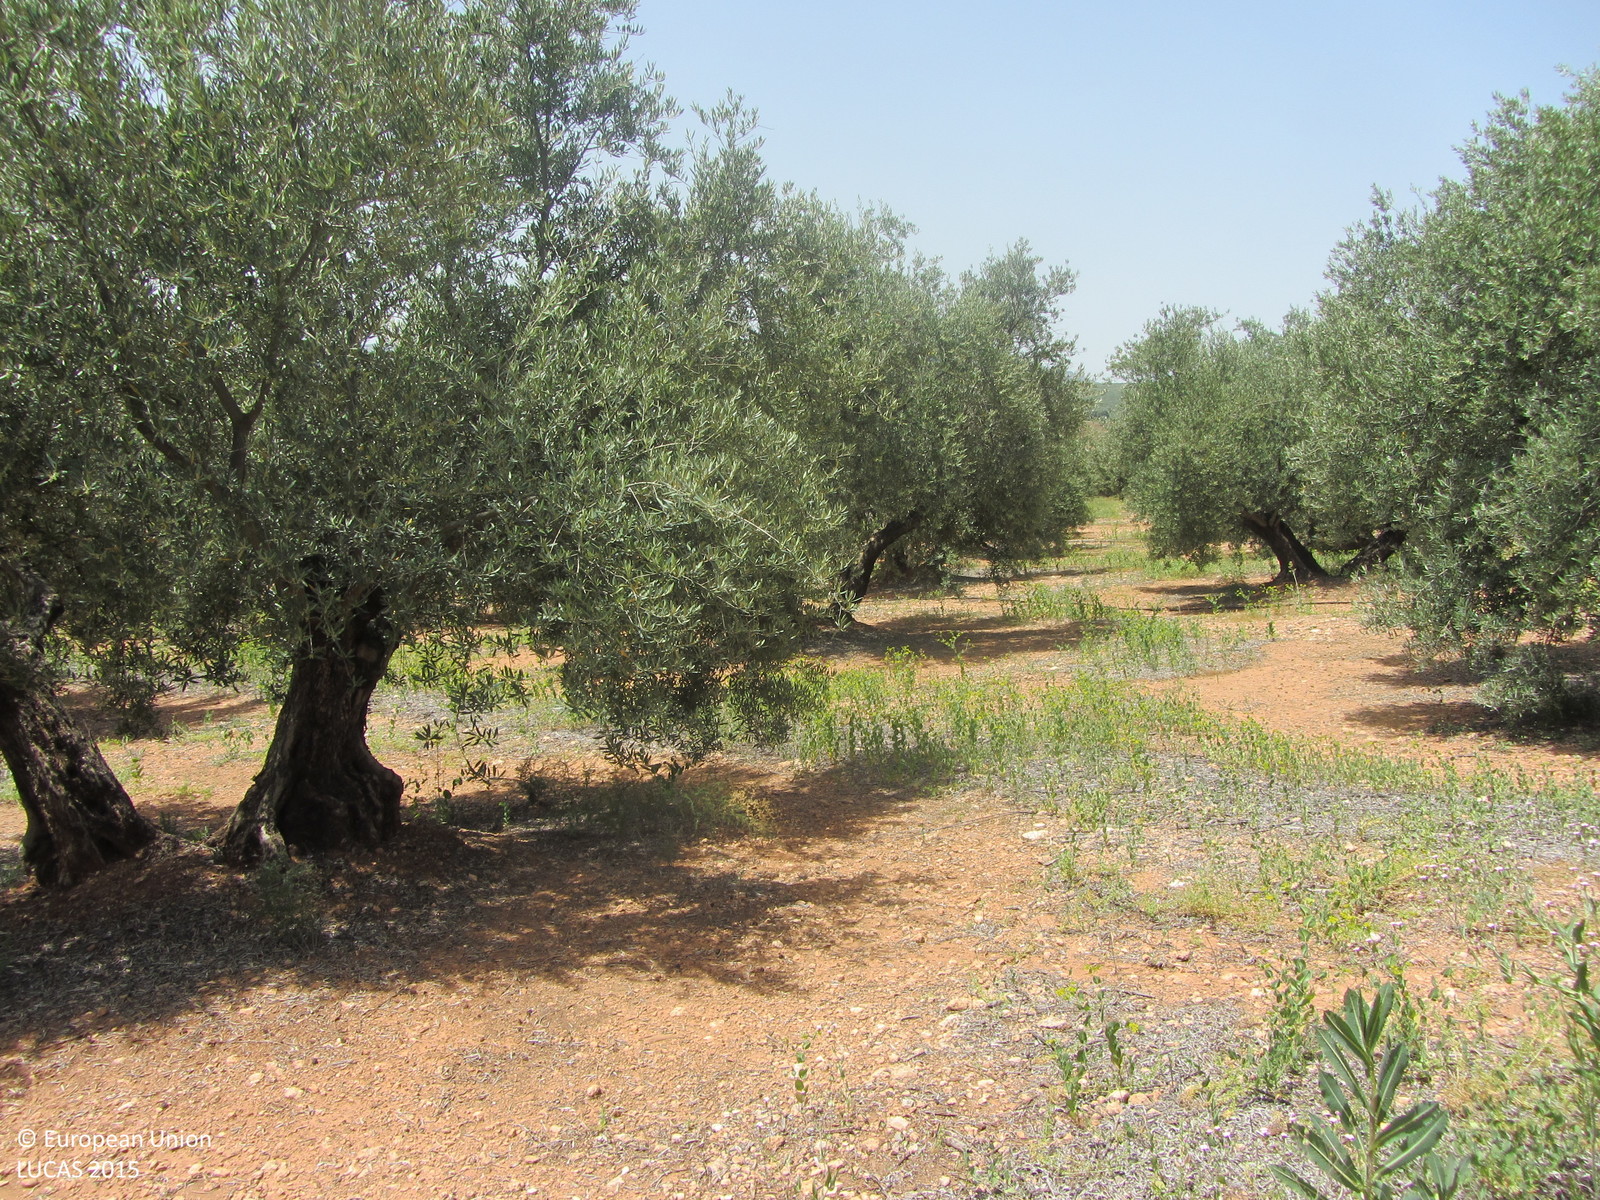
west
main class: Cropland
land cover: Olive groves
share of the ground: 25 - 50 %
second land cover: Spontaneously vegetated surfaces
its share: 10 - 25 %
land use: Agriculture (excluding fallow land and kitchen gardens)
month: May
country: ES
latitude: 38.2876
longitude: -2.9534
